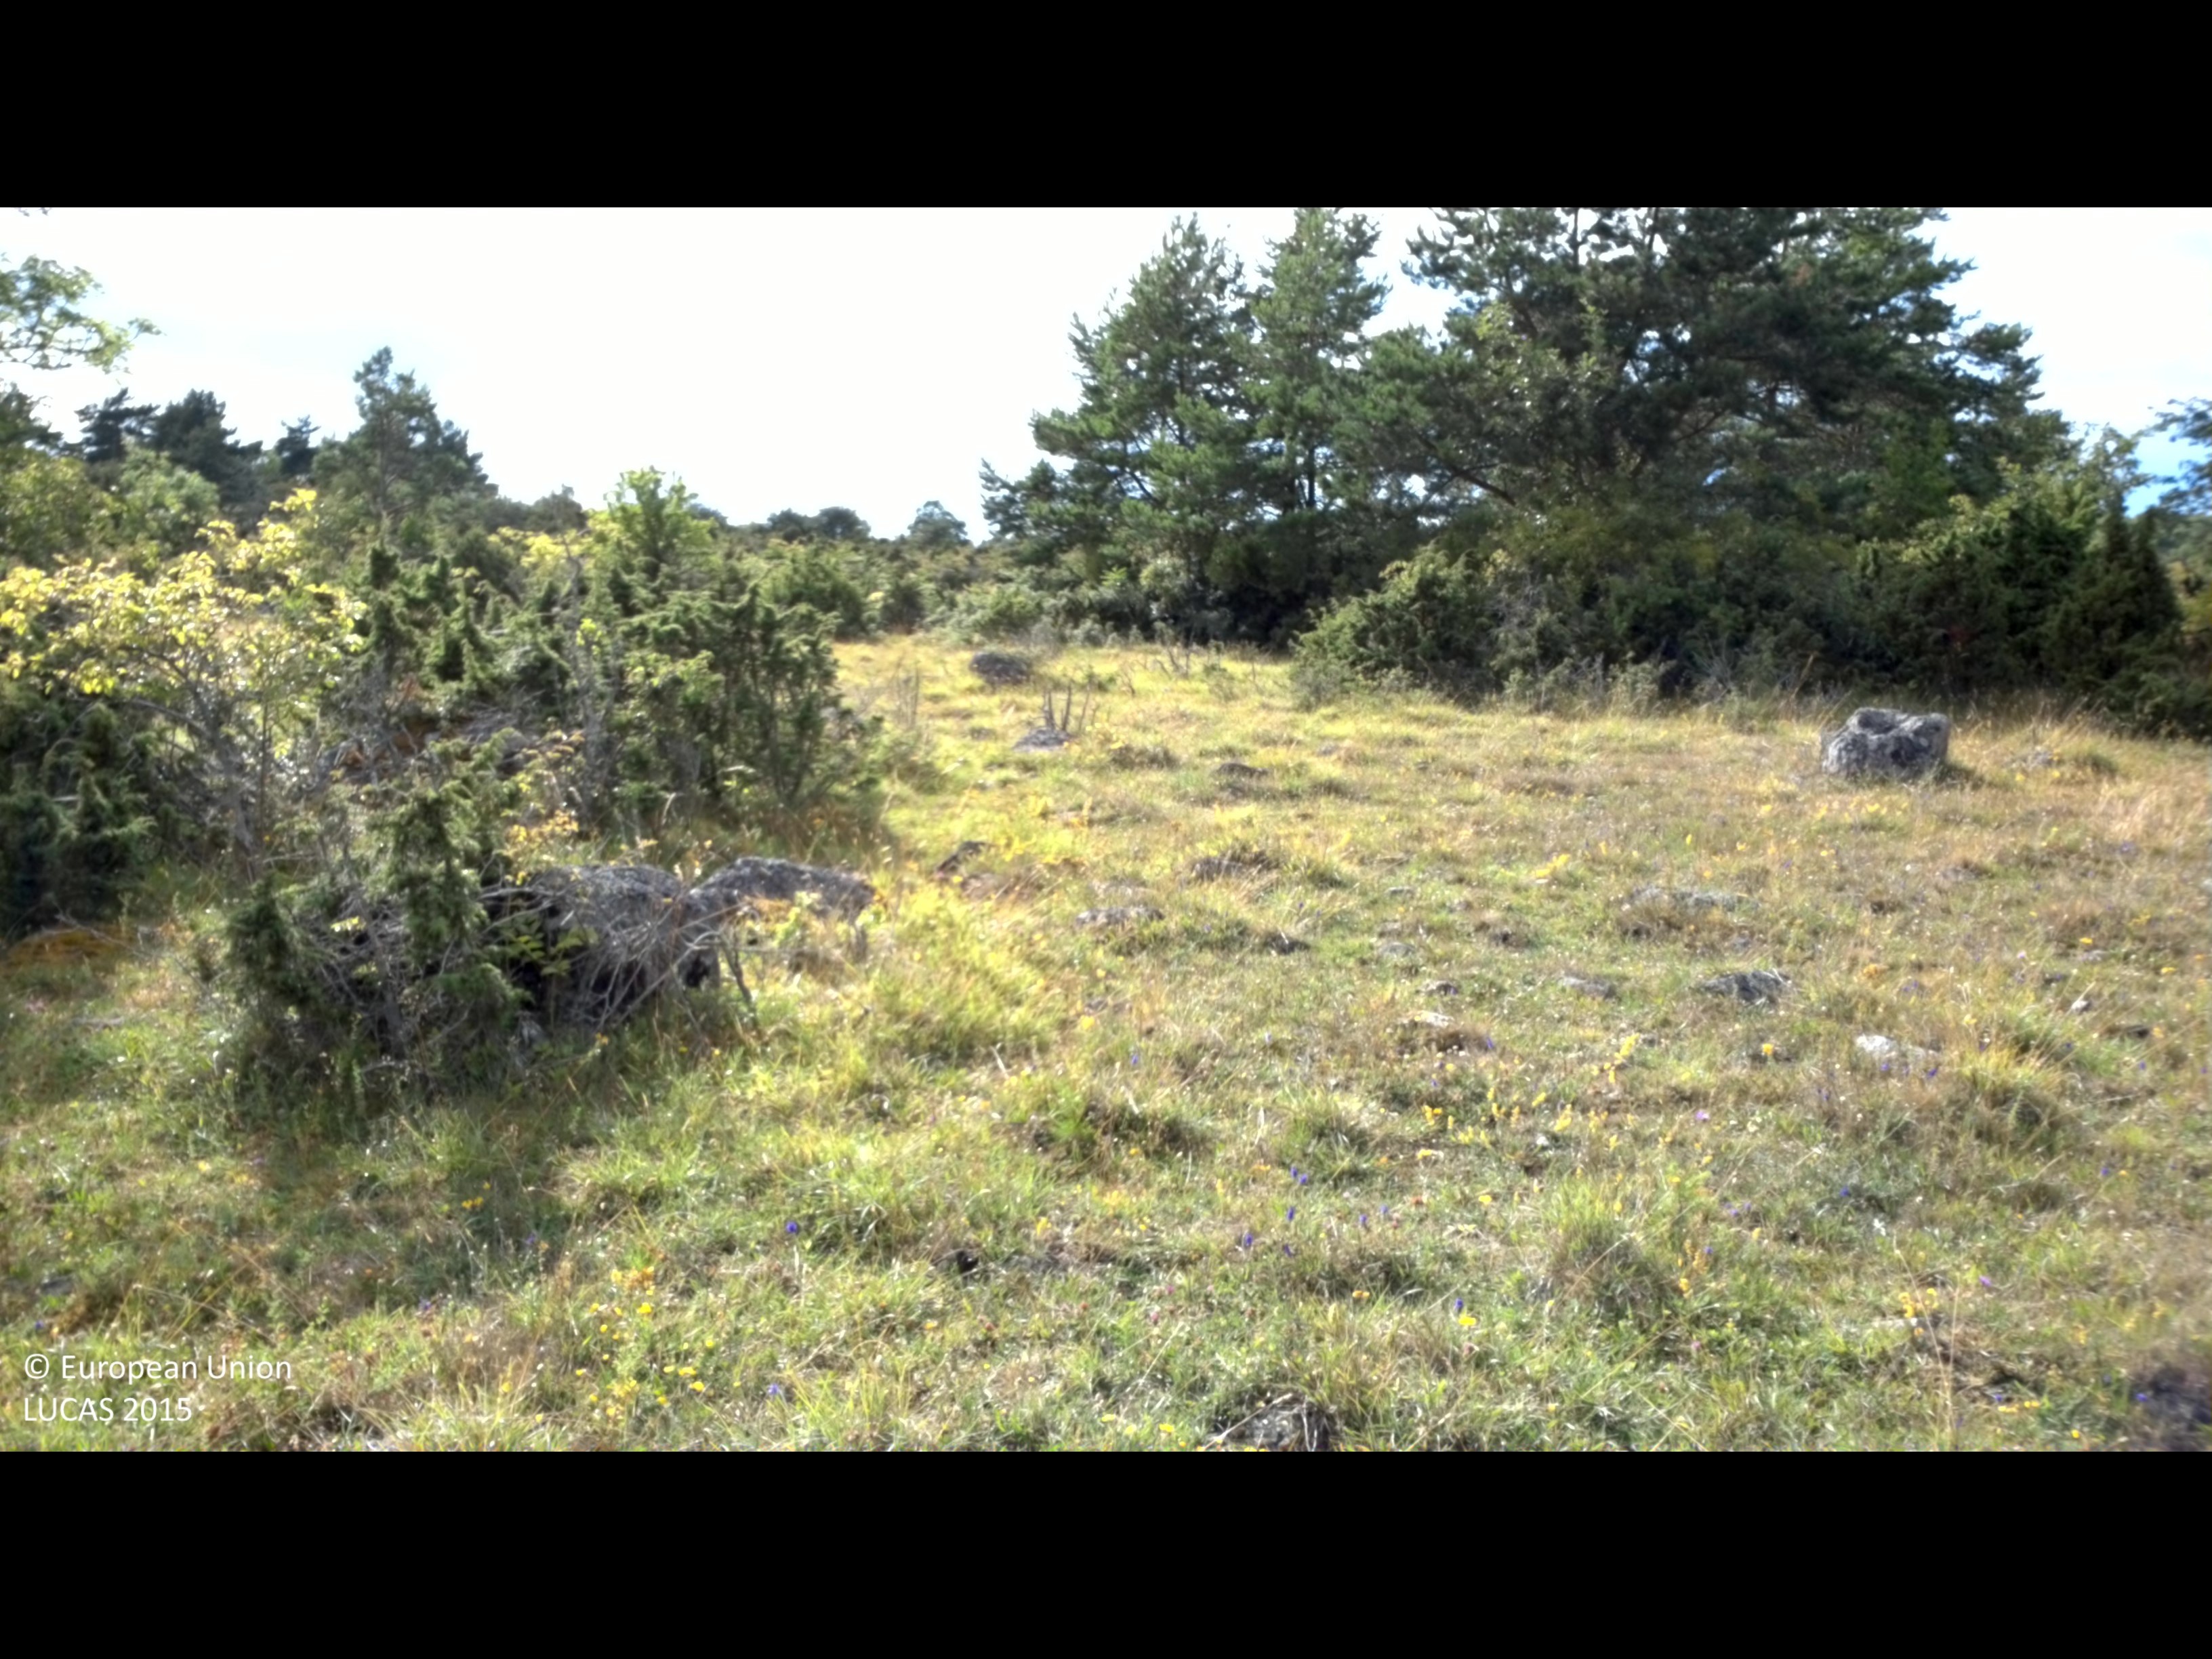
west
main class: Grassland
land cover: Grassland without tree/shrub cover
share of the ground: > 75 %
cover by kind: herbaceous plants 95 %, shrubs 5 %
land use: Agriculture (excluding fallow land and kitchen gardens)
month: July
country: SE
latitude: 57.1738
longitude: 16.9318
